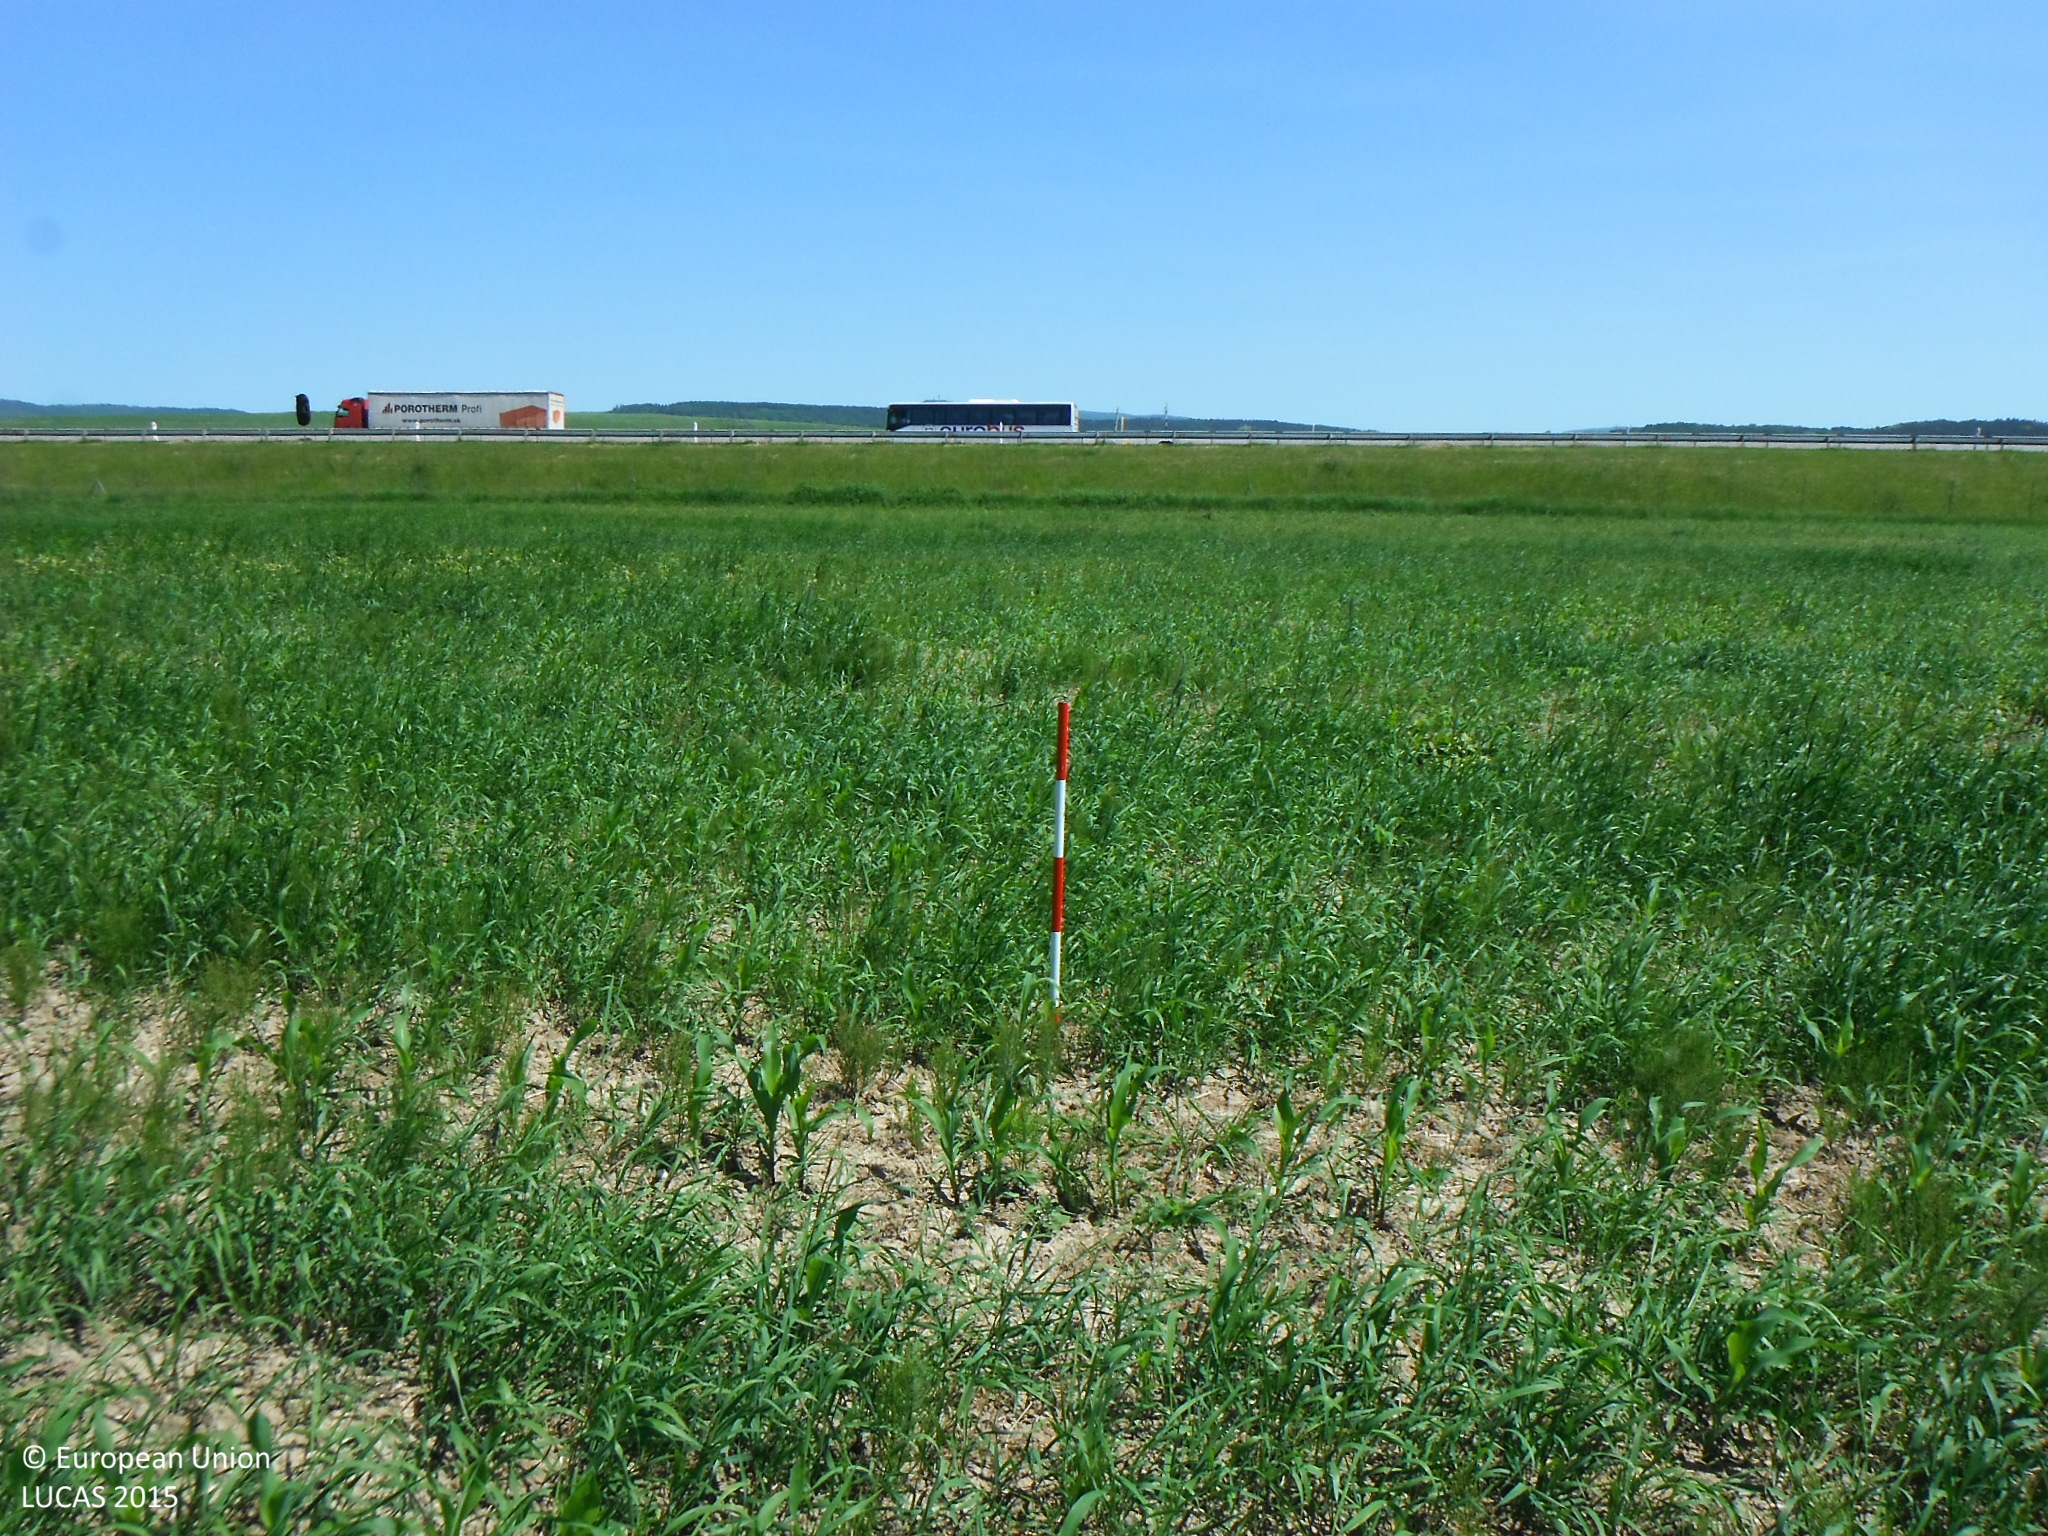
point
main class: Cropland
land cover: Maize
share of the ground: 10 - 25 %
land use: Agriculture (excluding fallow land and kitchen gardens)
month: June
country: SK
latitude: 48.8204
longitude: 21.3090
